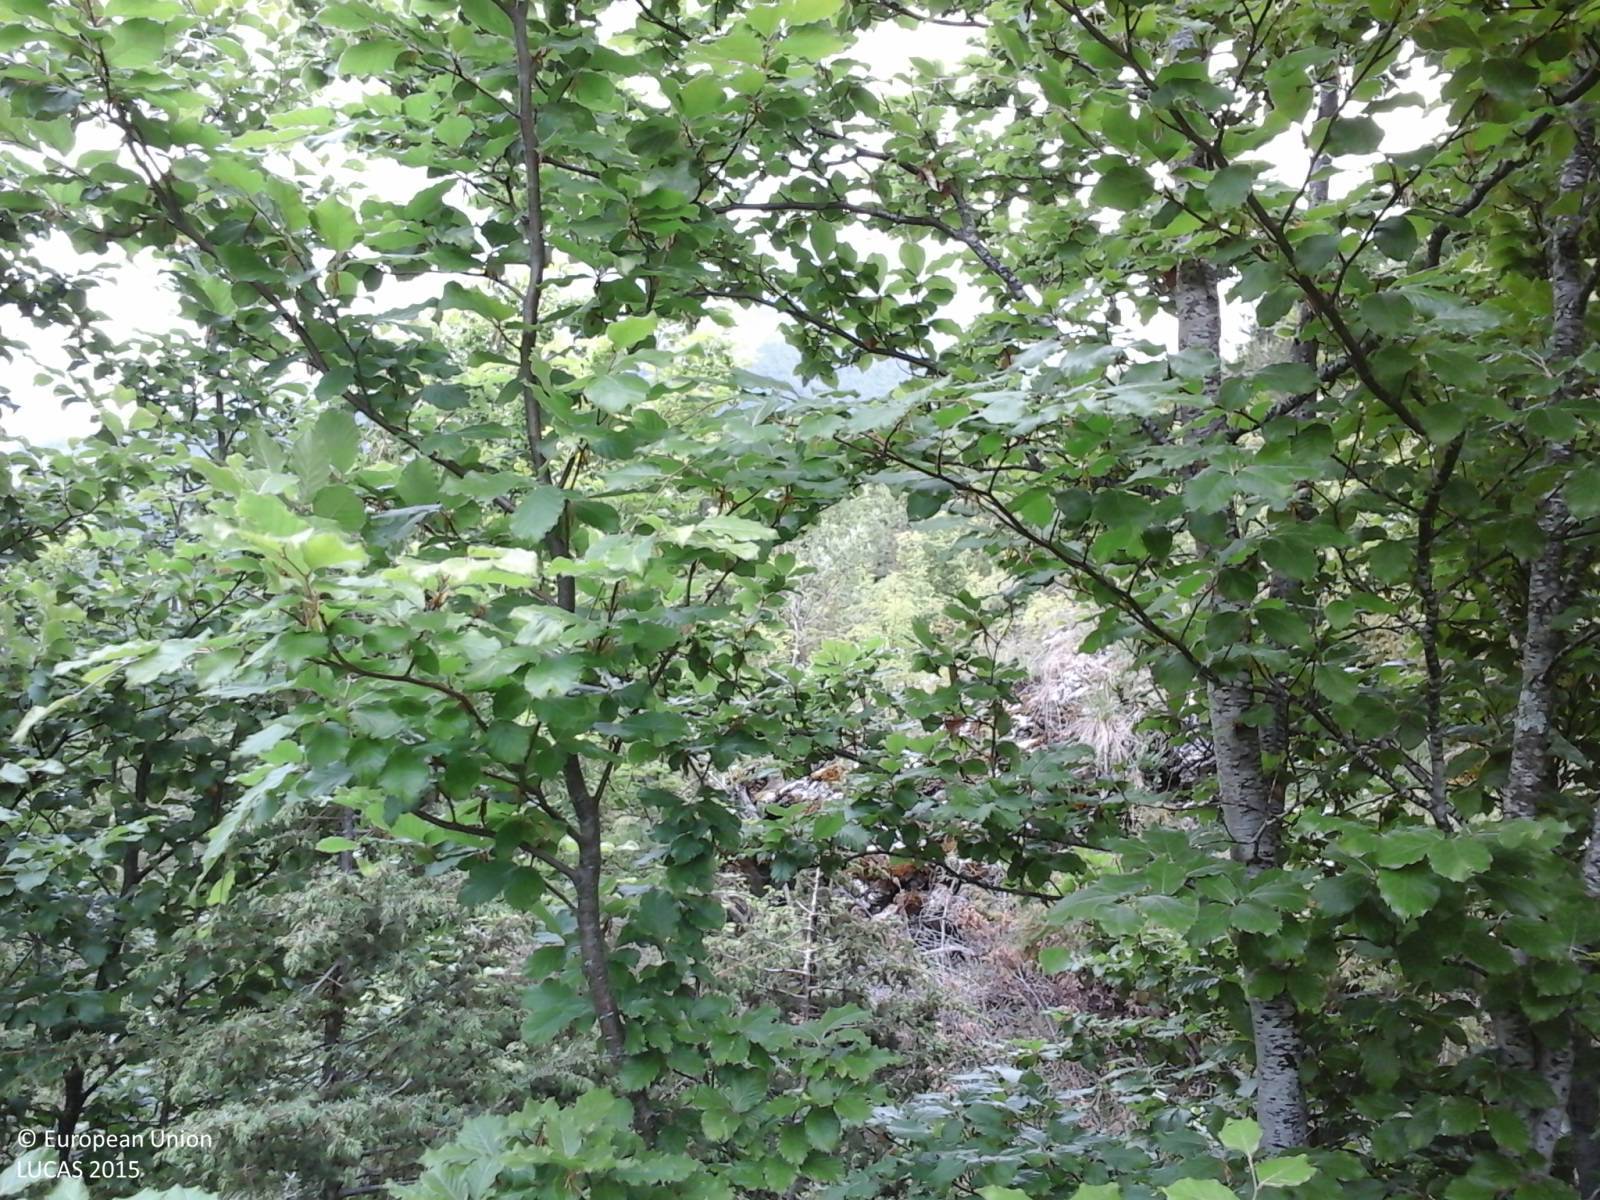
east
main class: Woodland
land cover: Broadleaved woodland
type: mountainous beech forest
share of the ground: 25 - 50 %
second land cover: Grassland without tree/shrub cover
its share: > 75 %
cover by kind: broadleaved forest trees 70 %, shrubs 20 %, herbaceous plants 10 %
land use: Forestry
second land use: Agriculture (excluding fallow land and kitchen gardens)
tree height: > 5 m
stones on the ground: < 10 %
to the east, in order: Broadleaved woodland; Grassland without tree/shrub cover; Shrubland with sparse tree cover; Broadleaved woodland; Shrubland without tree cover
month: May
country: IT
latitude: 41.8231
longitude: 13.8031
